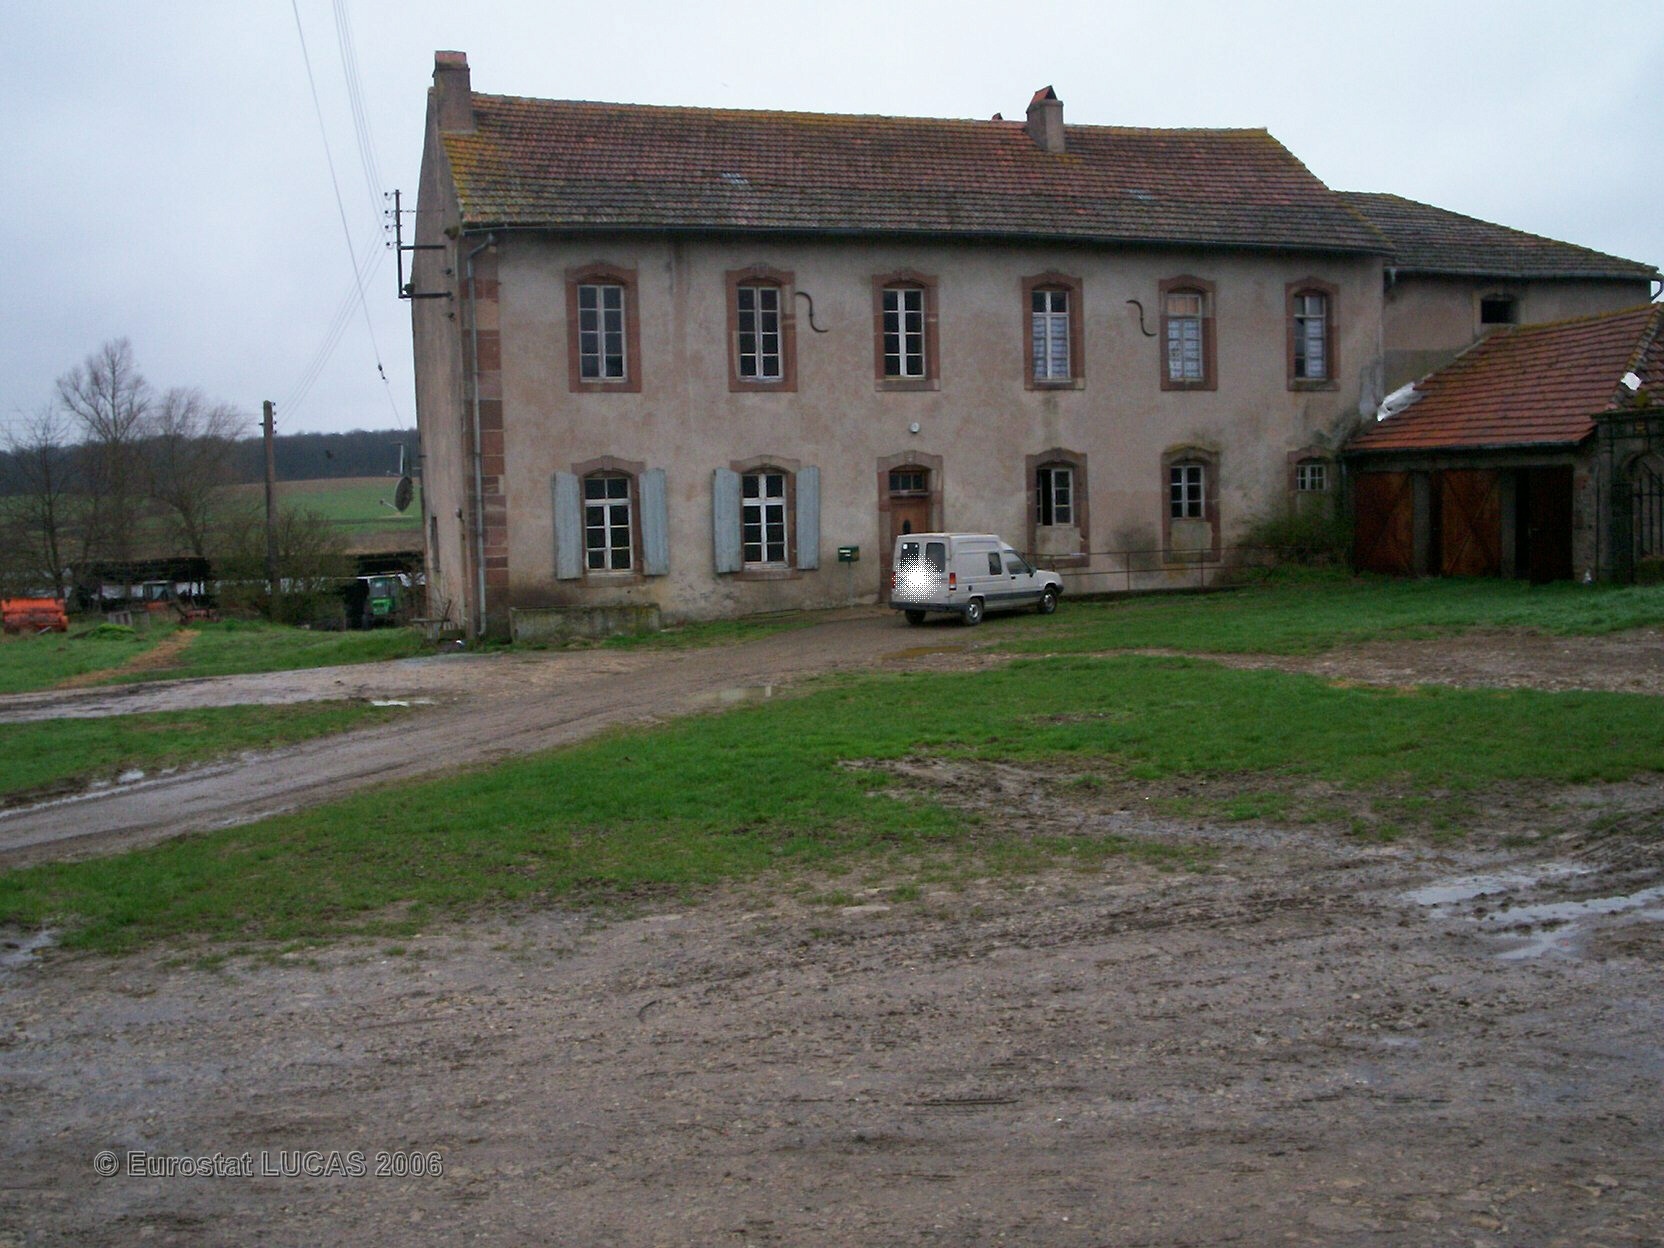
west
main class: Grassland
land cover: Grassland without tree/shrub cover
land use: Agriculture (excluding fallow land and kitchen gardens)
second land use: Residential
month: April
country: FR
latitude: 48.7228
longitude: 6.9964
